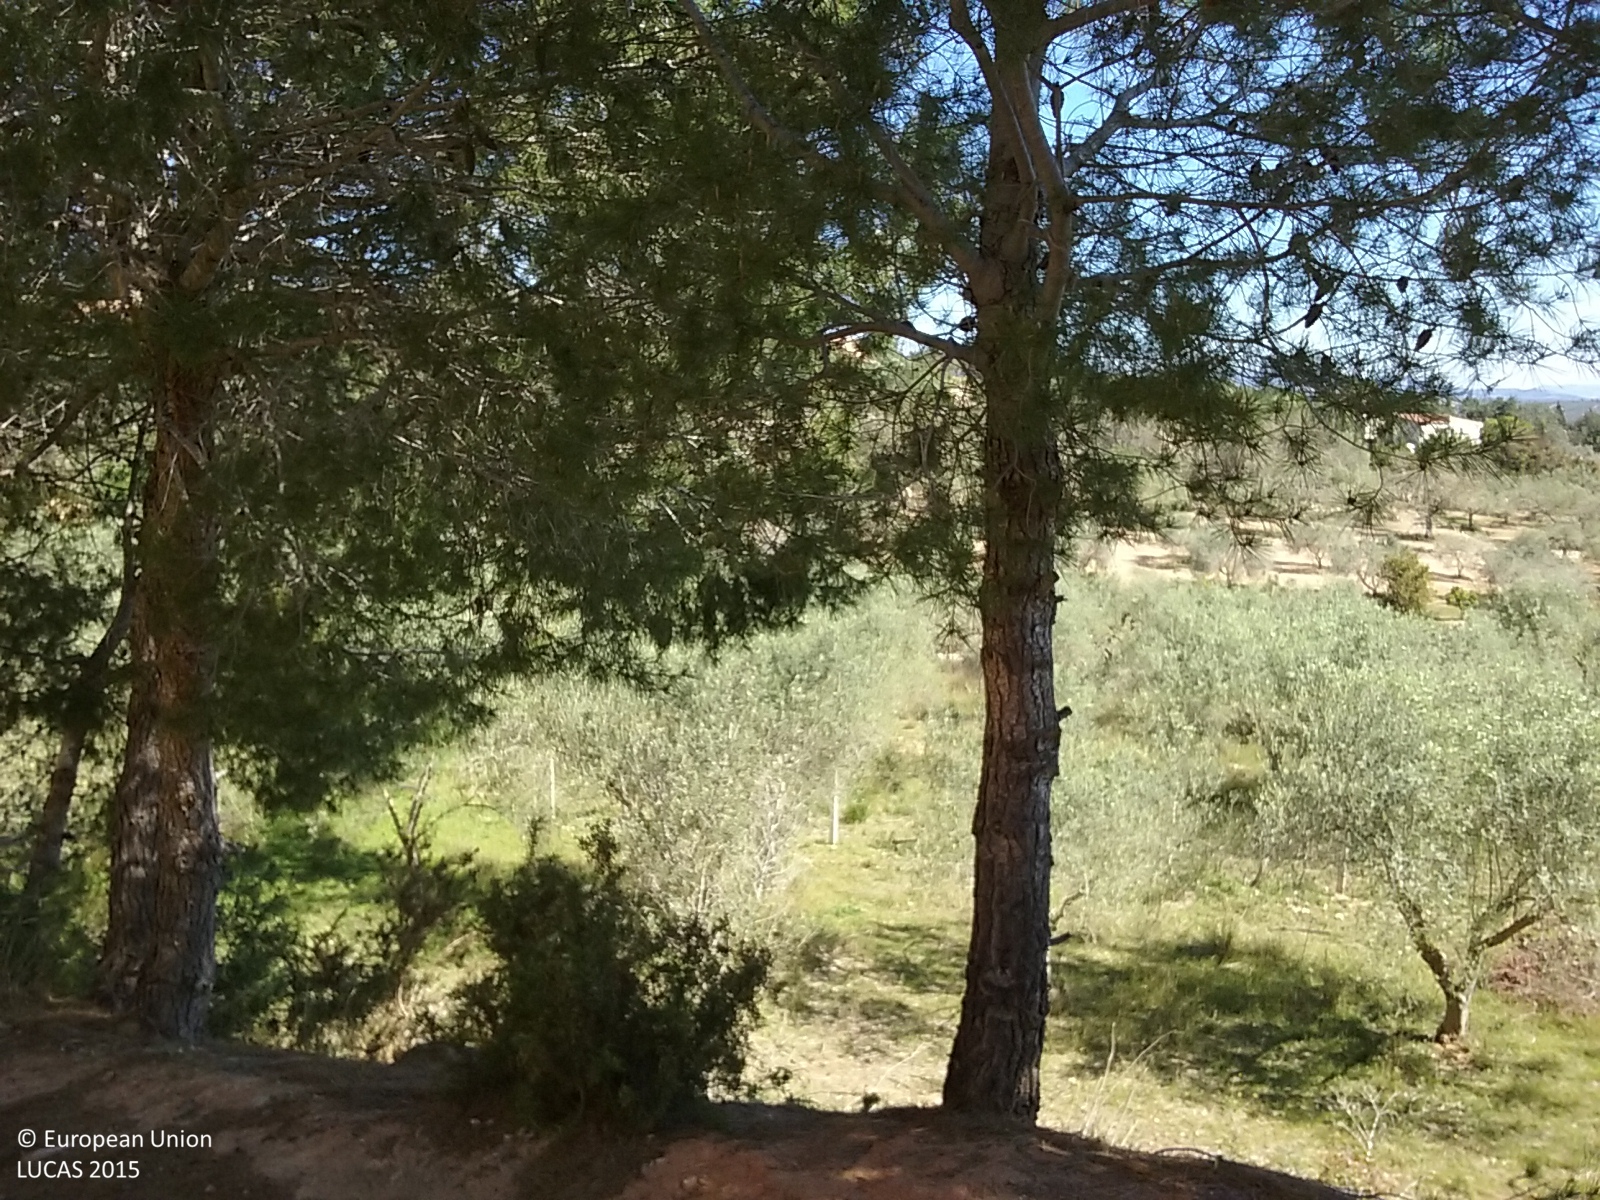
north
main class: Cropland
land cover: Permanent crops (only in case pi)
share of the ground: 25 - 50 %
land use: Agriculture (excluding fallow land and kitchen gardens)
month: April
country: ES
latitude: 40.7212
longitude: 0.5593
